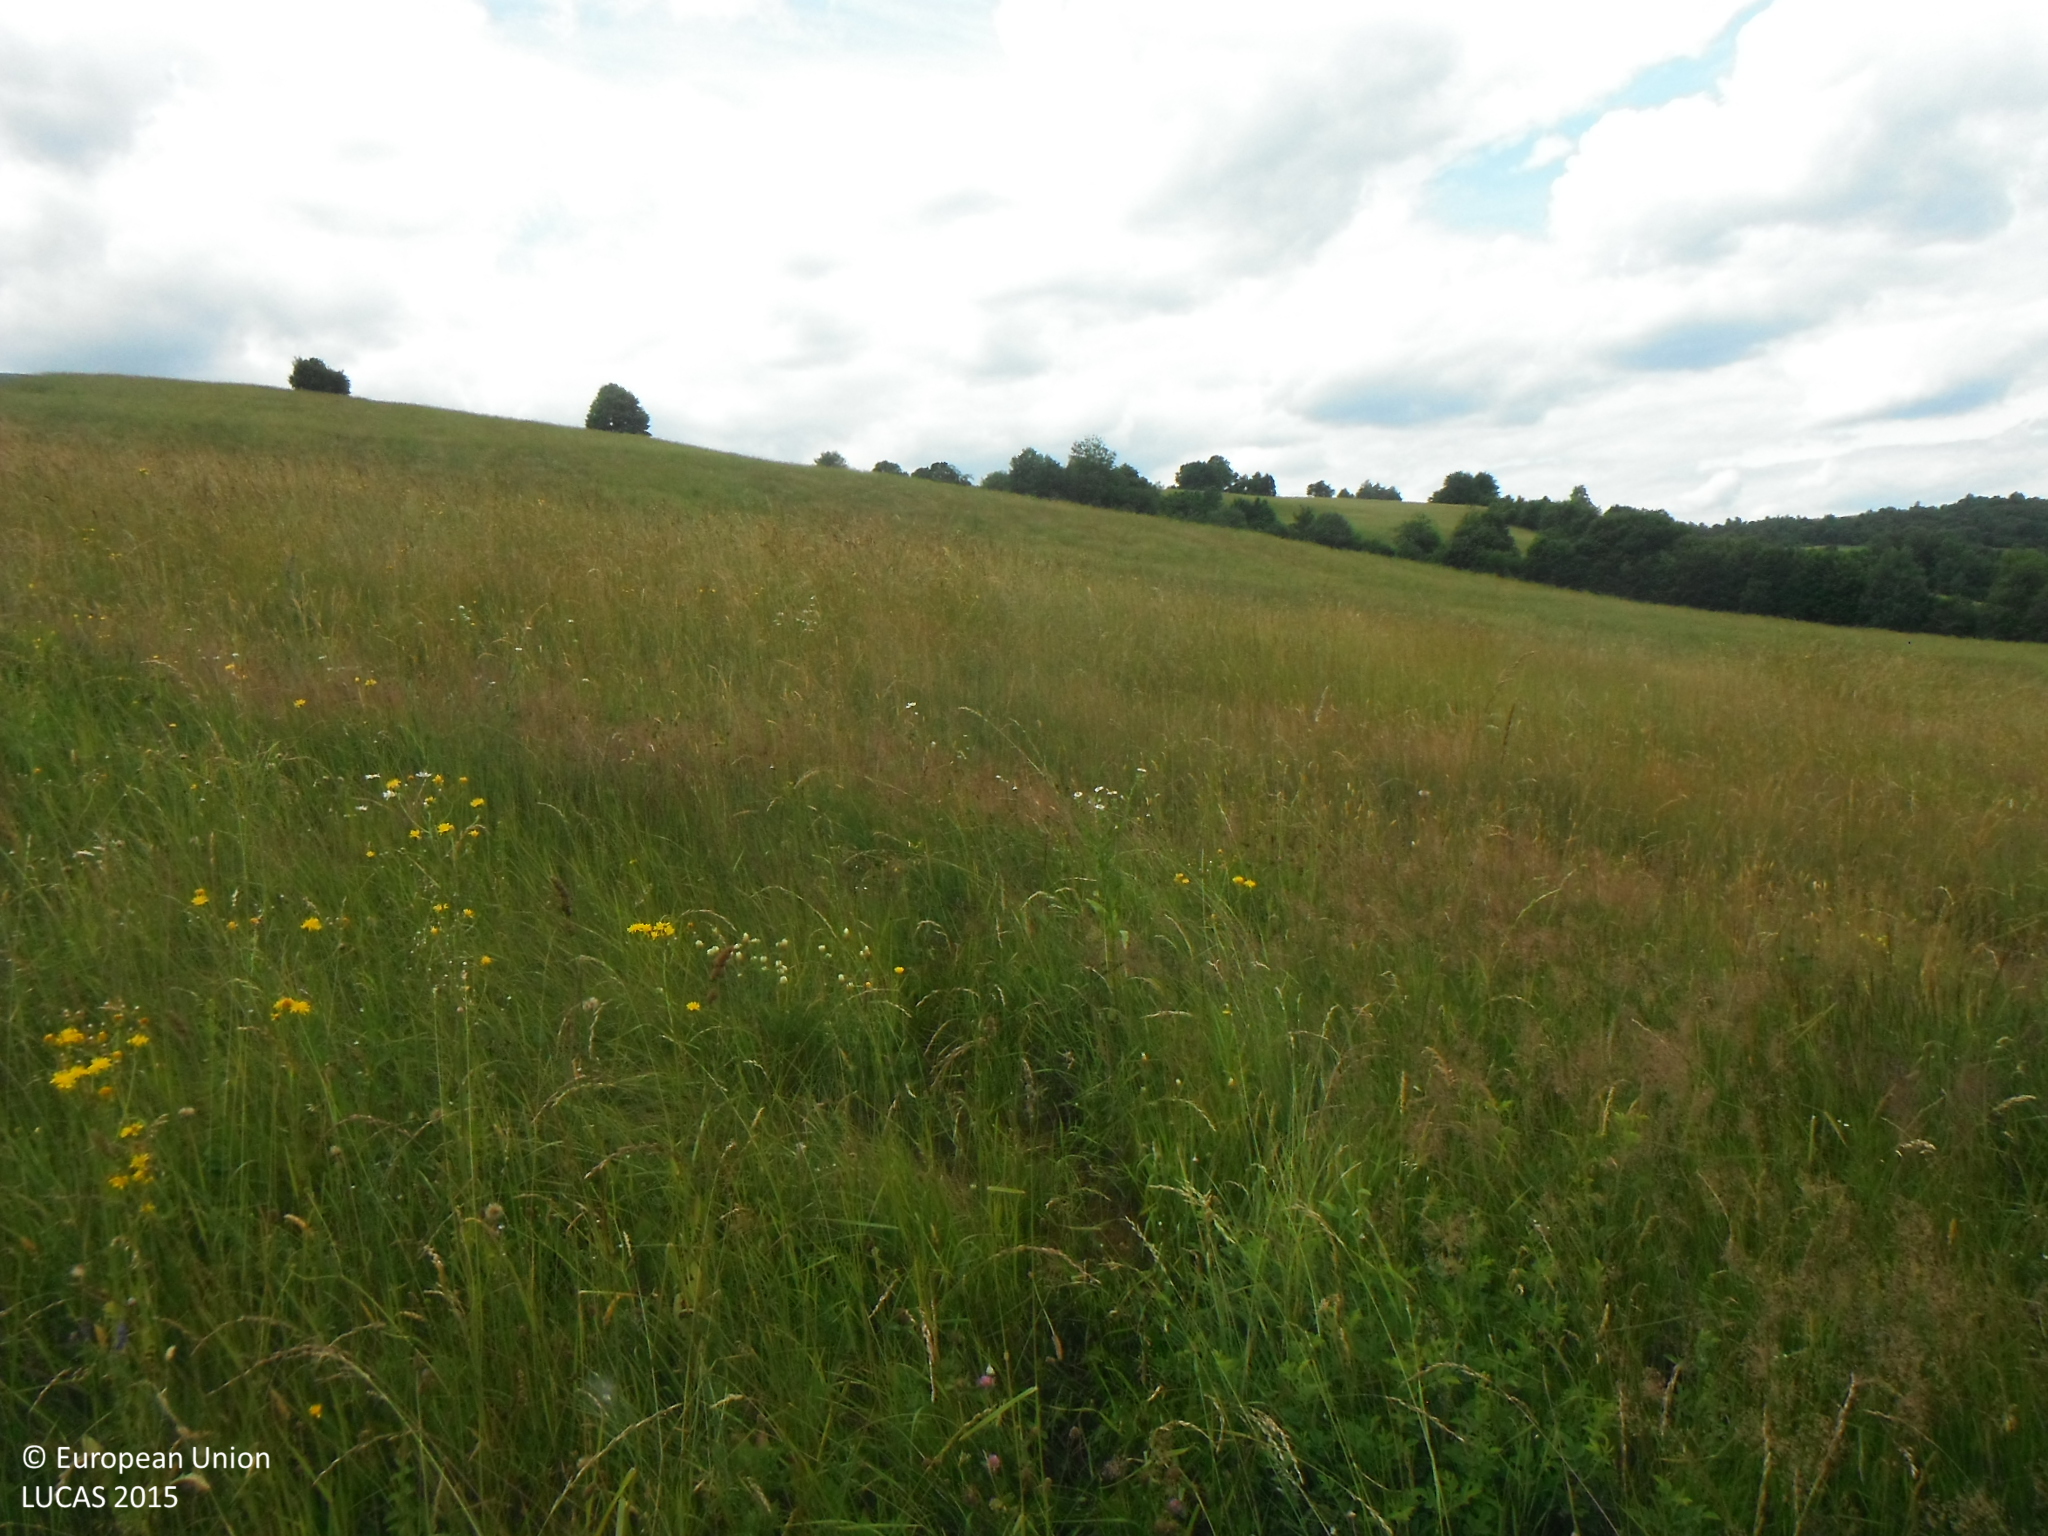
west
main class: Grassland
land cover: Grassland without tree/shrub cover
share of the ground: > 75 %
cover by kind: herbaceous plants 100 %
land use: Agriculture (excluding fallow land and kitchen gardens)
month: June
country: SK
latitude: 48.9442
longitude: 22.3628
